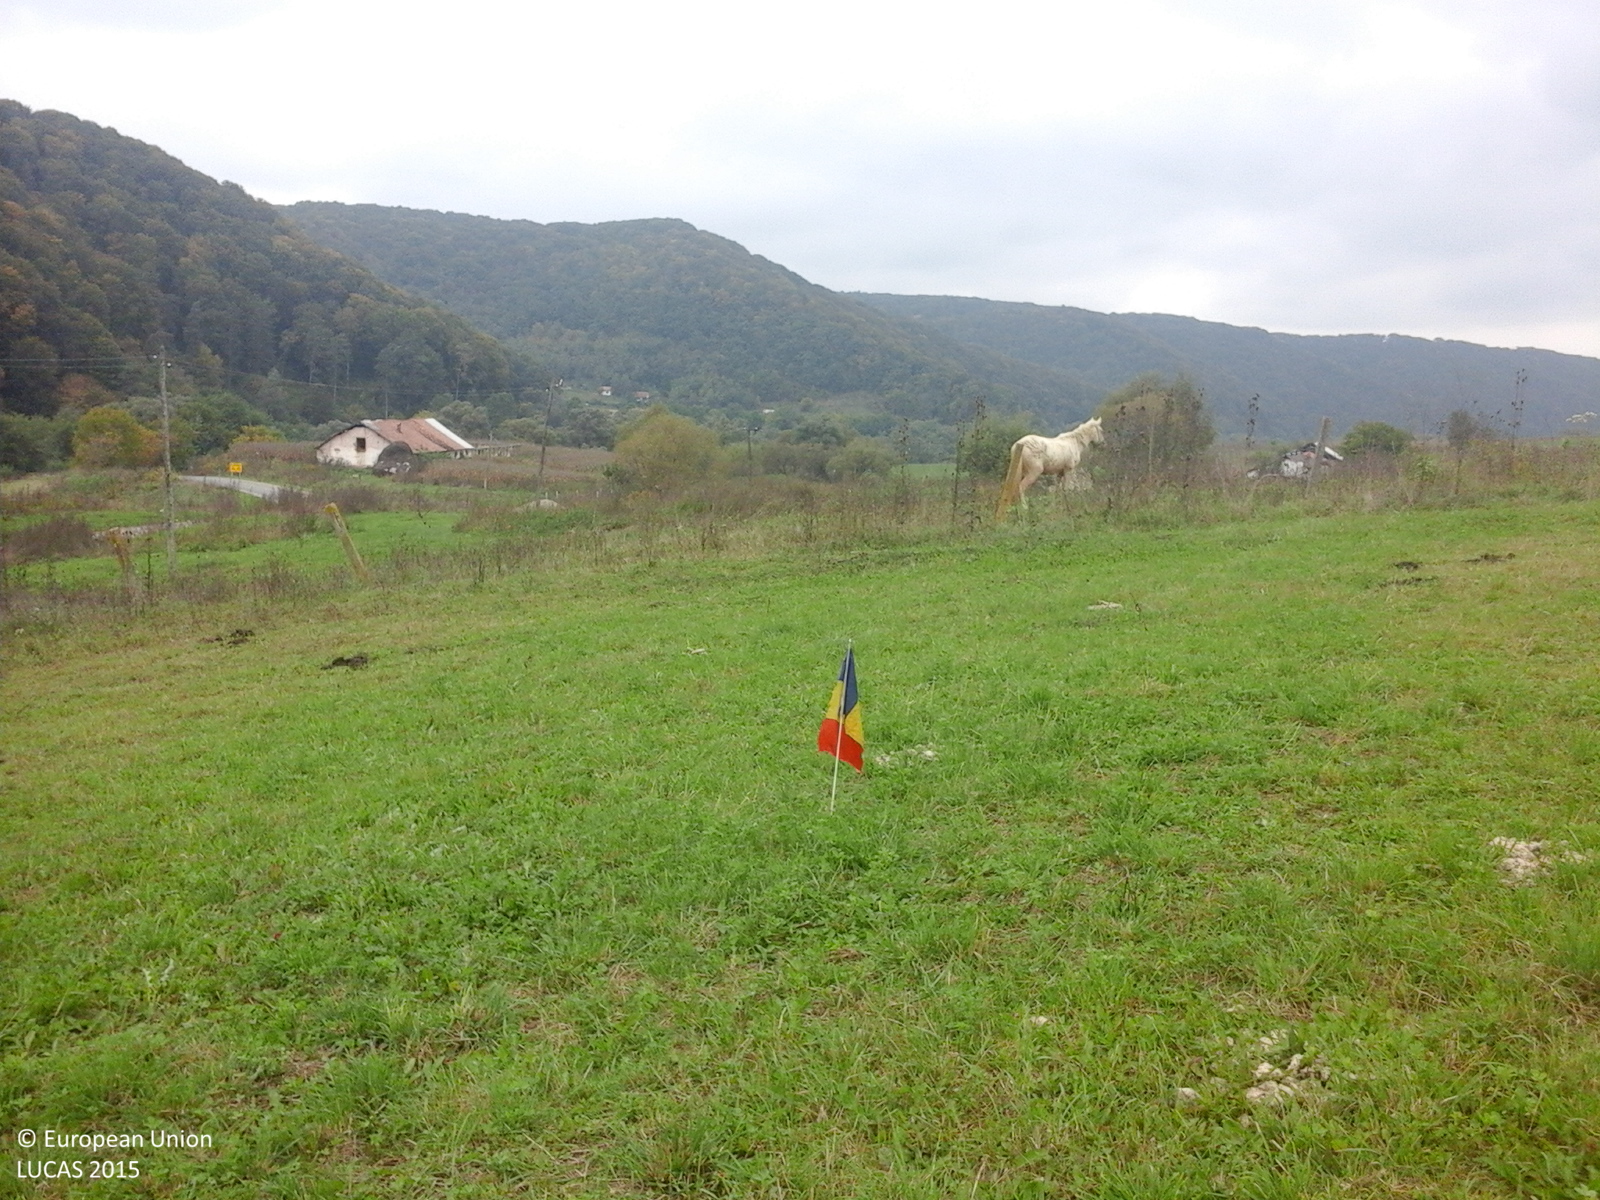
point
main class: Grassland
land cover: Grassland without tree/shrub cover
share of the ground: > 75 %
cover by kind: herbaceous plants 100 %
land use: Agriculture (excluding fallow land and kitchen gardens)
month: October
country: RO
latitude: 46.1616
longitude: 24.7624
